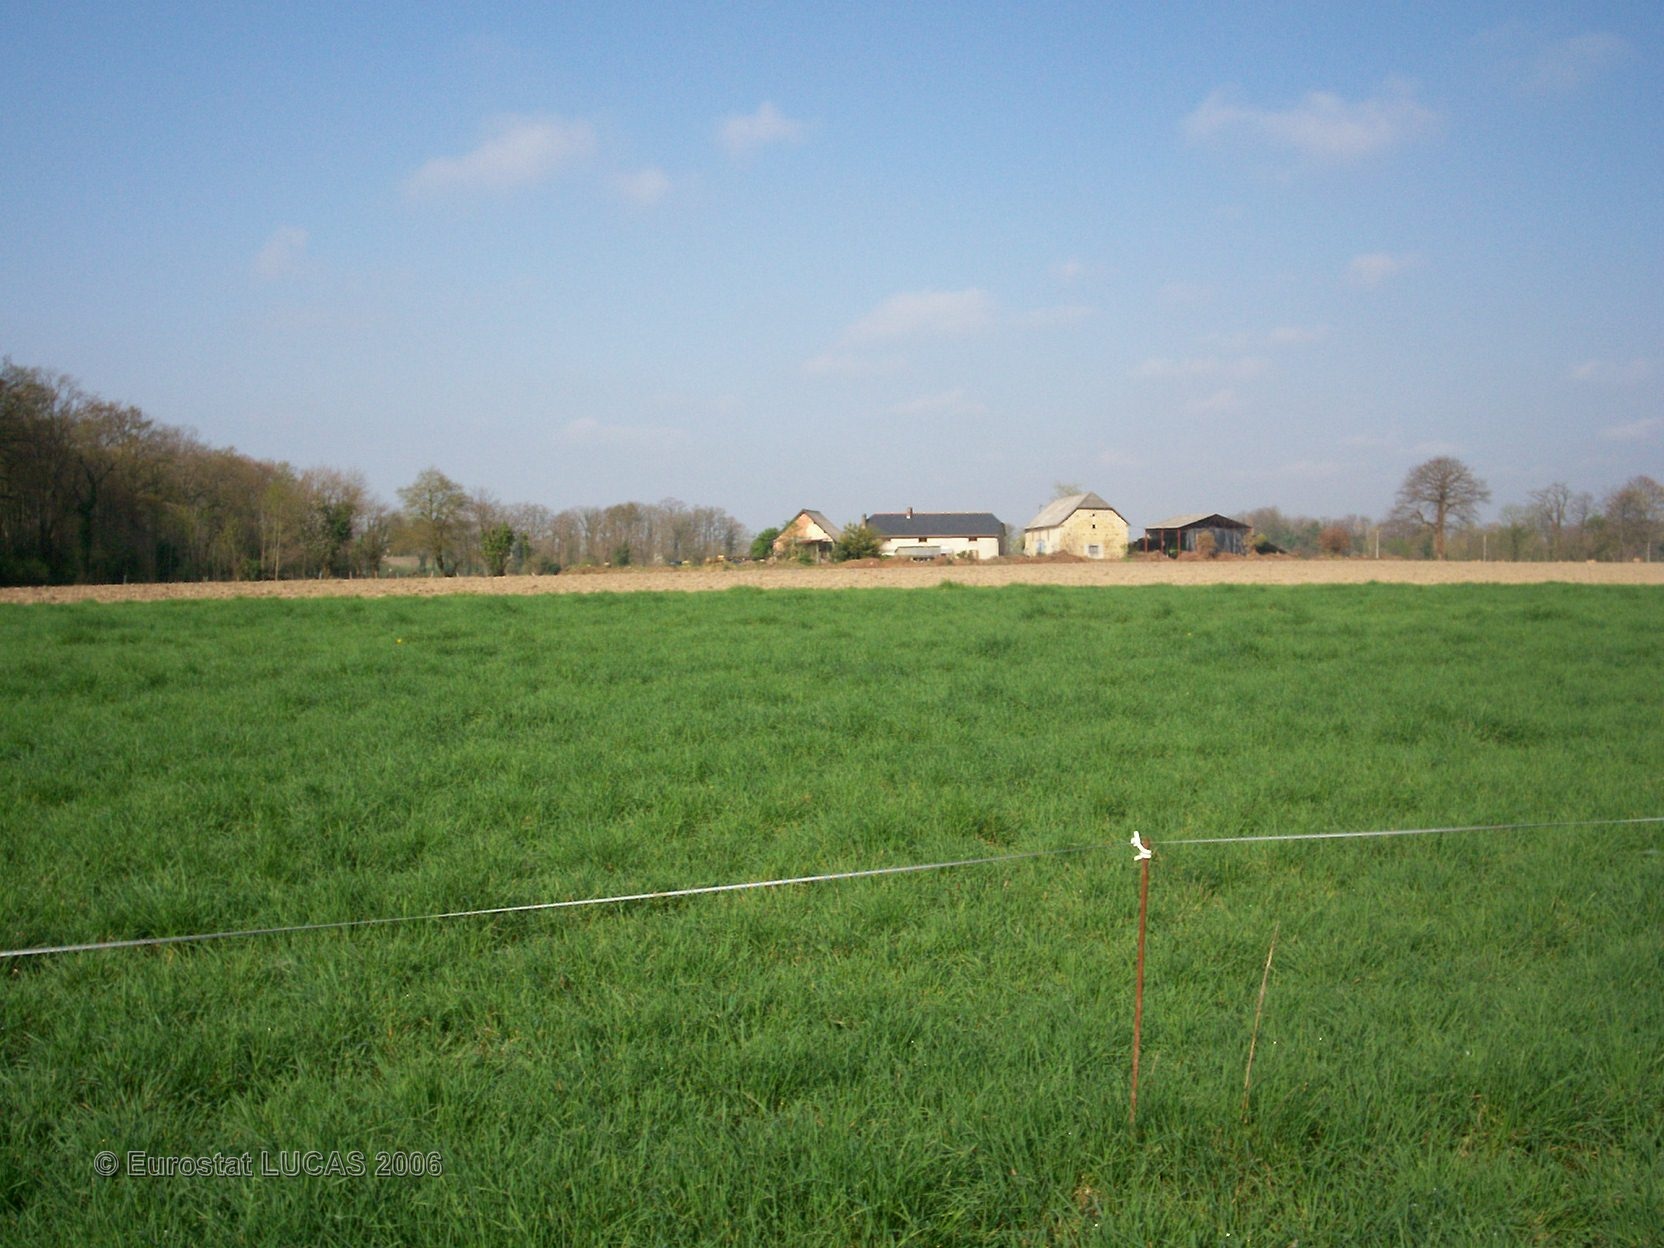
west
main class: Grassland
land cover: Grassland without tree/shrub cover
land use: Agriculture (excluding fallow land and kitchen gardens)
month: April
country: FR
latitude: 43.3040
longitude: -0.1756
